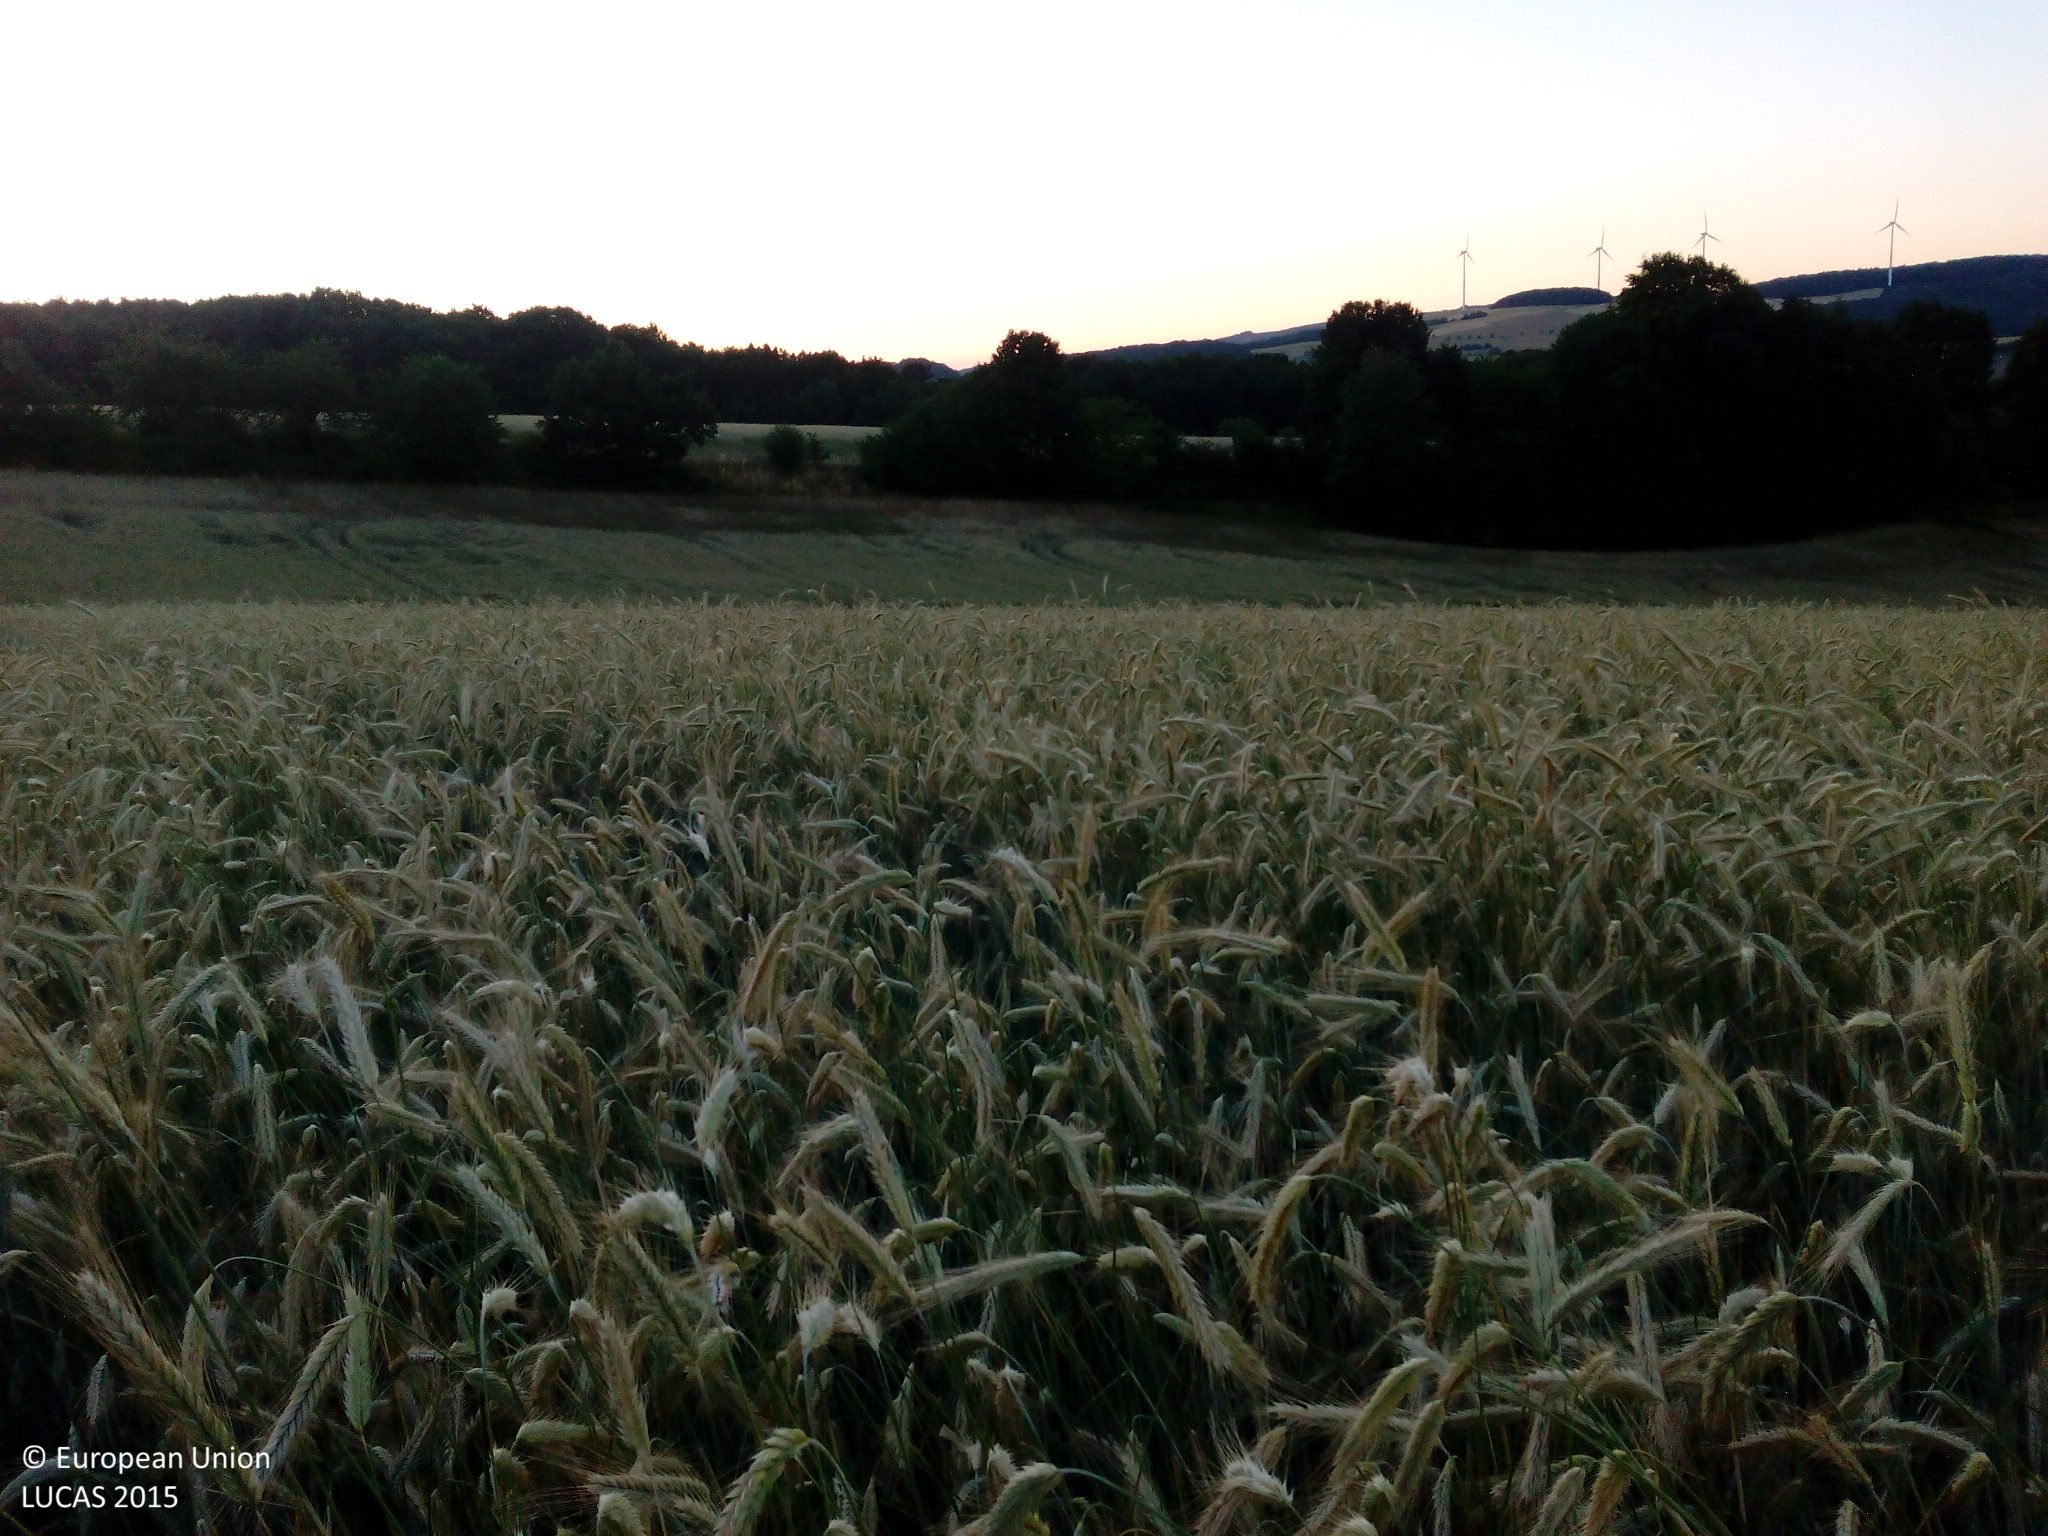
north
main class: Cropland
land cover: Barley
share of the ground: > 75 %
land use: Agriculture (excluding fallow land and kitchen gardens)
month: June
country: DE
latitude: 49.4918
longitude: 7.5292
